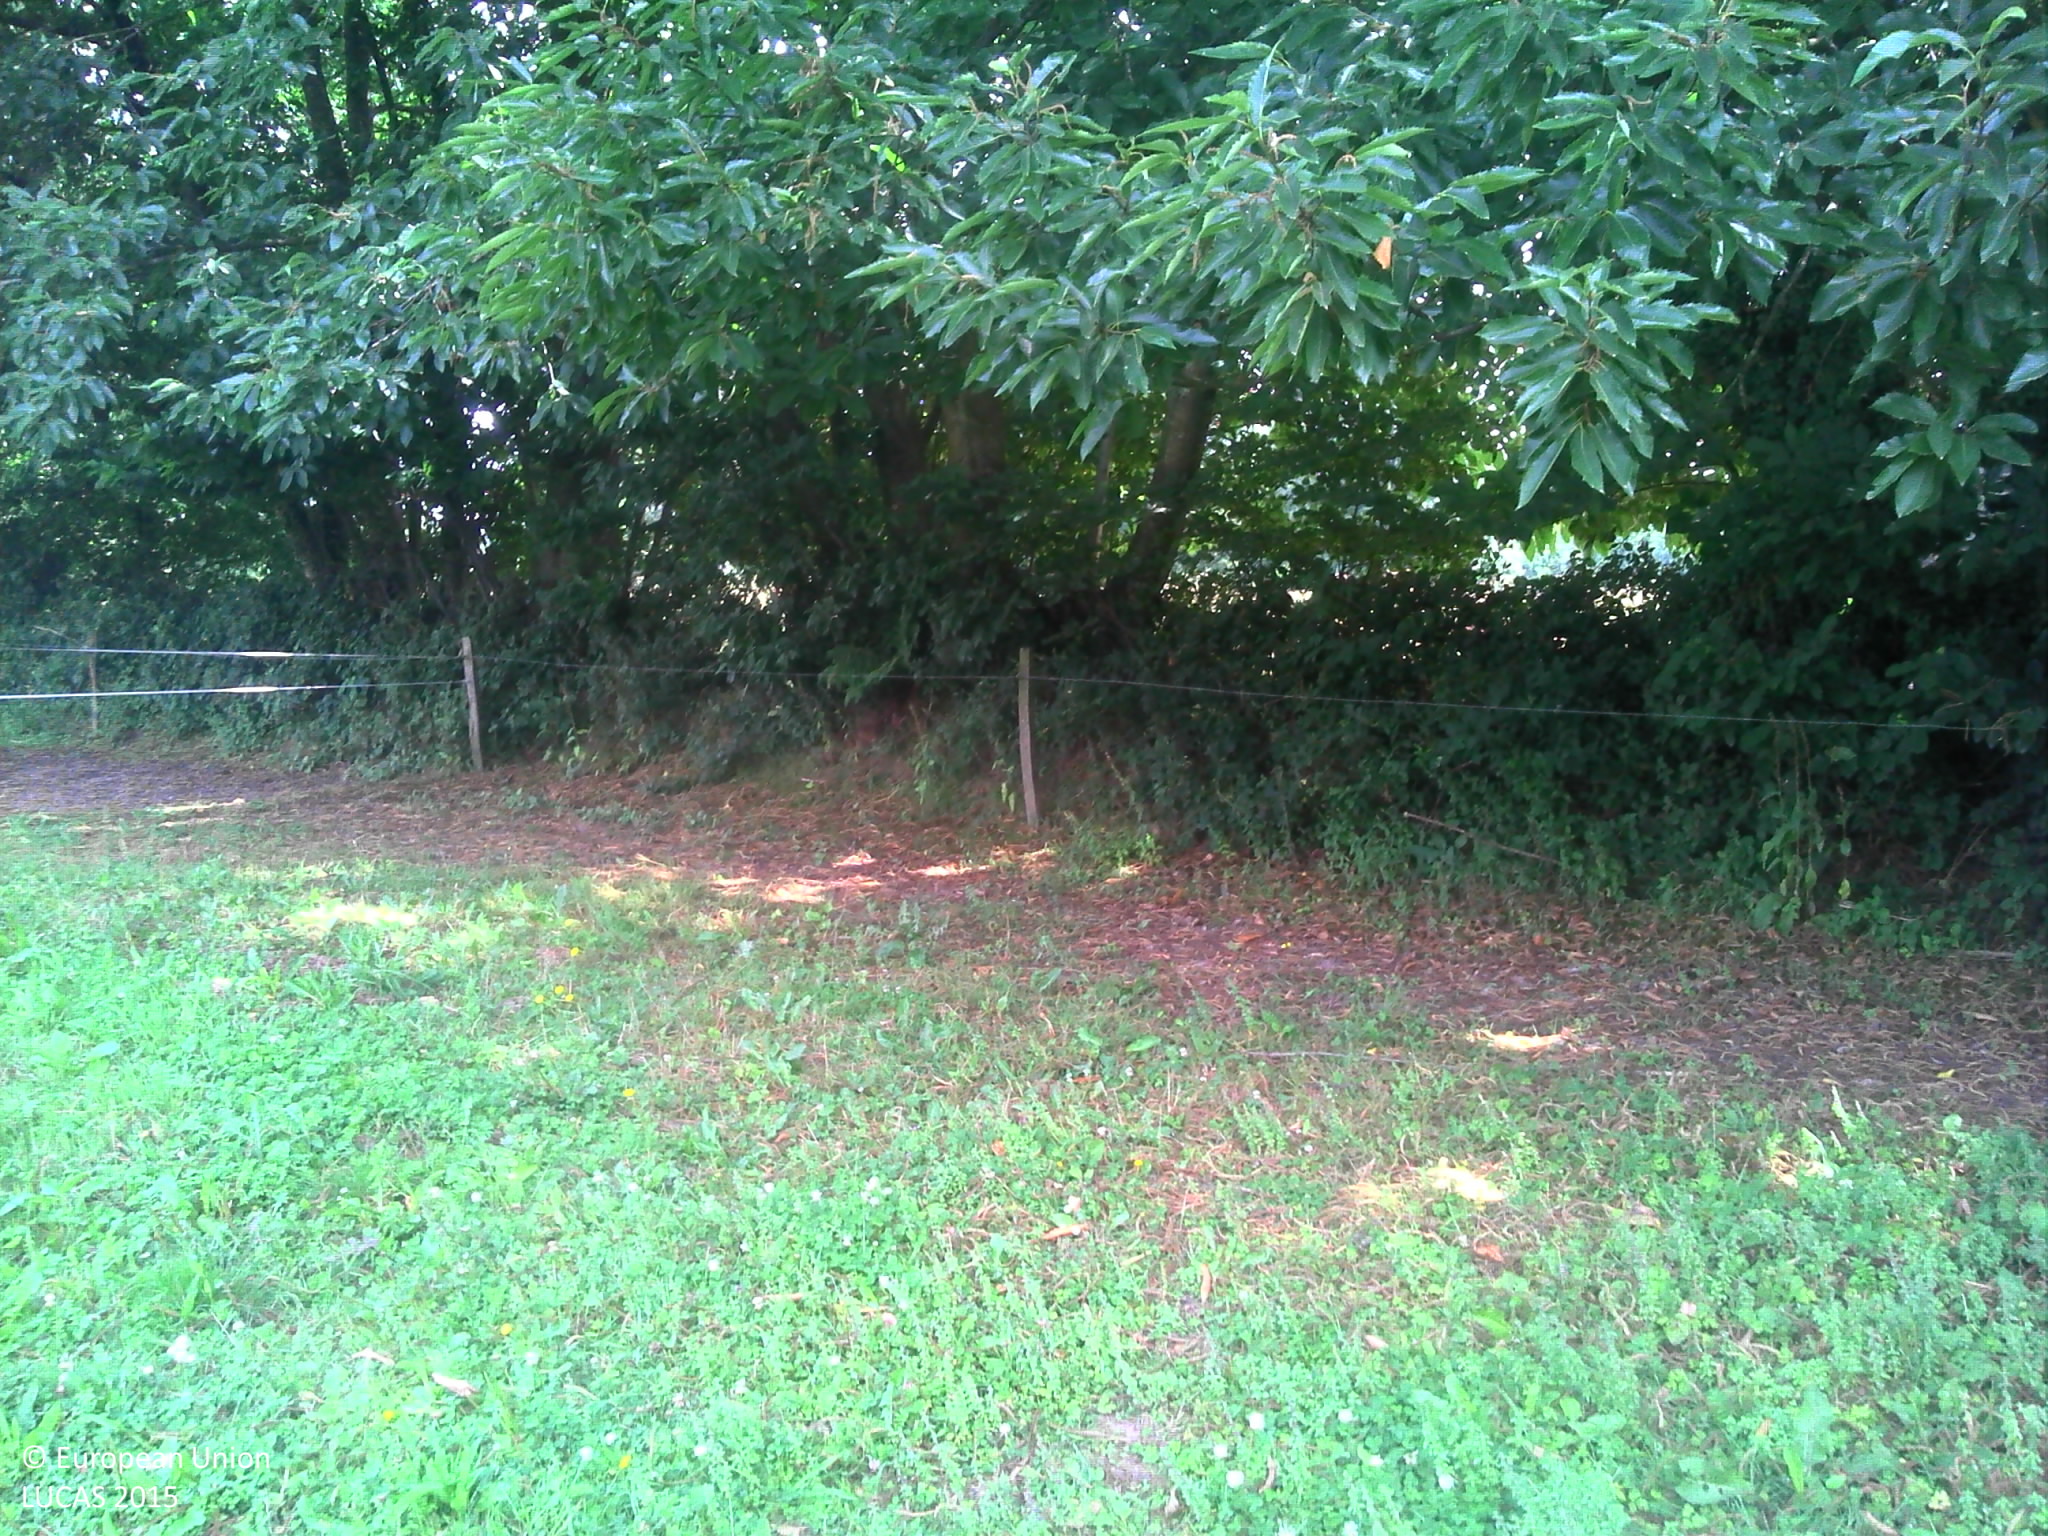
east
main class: Grassland
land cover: Grassland without tree/shrub cover
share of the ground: > 75 %
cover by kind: herbaceous plants 100 %
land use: Agriculture (excluding fallow land and kitchen gardens)
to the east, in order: Grassland without tree/shrub cover; Fences; Broadleaved woodland; Grassland without tree/shrub cover; Fences; Broadleaved woodland; Fences; Grassland without tree/shrub cover; Fences; Rivers and streams; Fences; Spontaneously vegetated surfaces; Ditches and canals; Grassland without tree/shrub cover
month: July
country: FR
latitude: 48.7794
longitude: -1.3548
